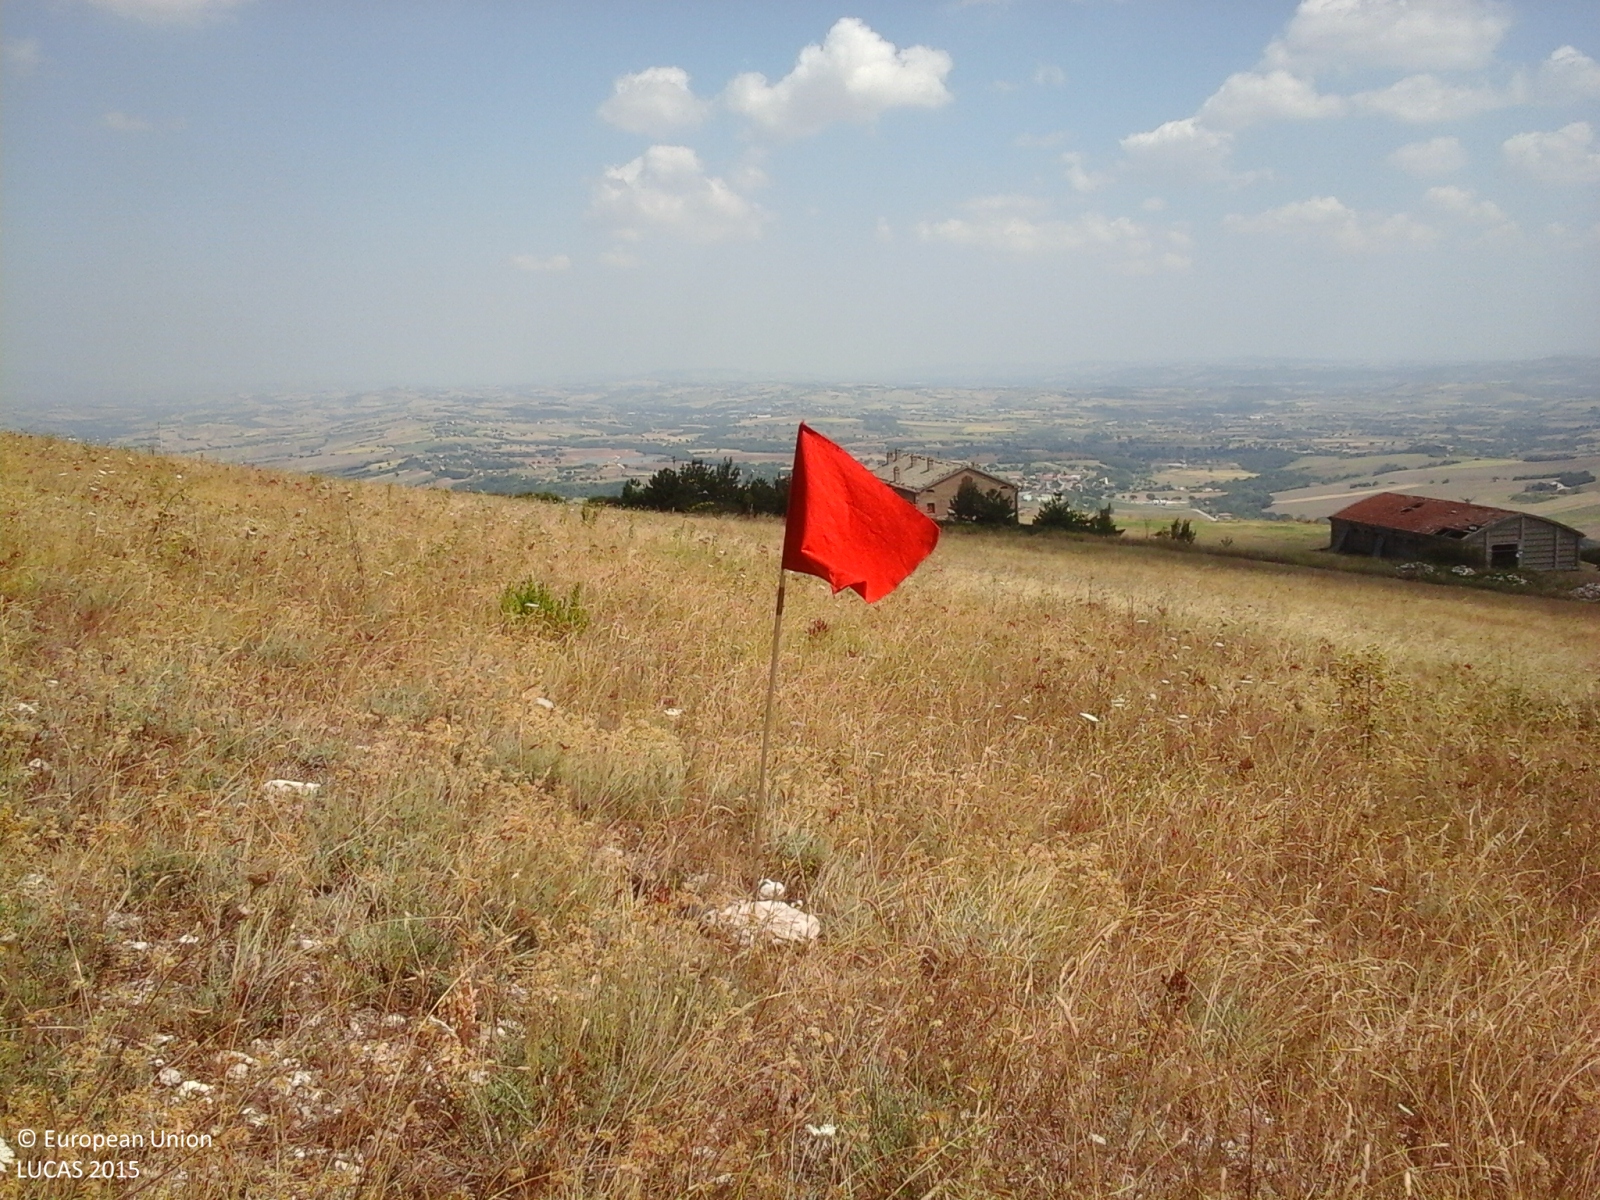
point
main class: Grassland
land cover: Grassland without tree/shrub cover
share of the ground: > 75 %
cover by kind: herbaceous plants 95 %, shrubs 5 %
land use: Agriculture (excluding fallow land and kitchen gardens)
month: August
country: IT
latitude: 43.3432
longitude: 13.2359
